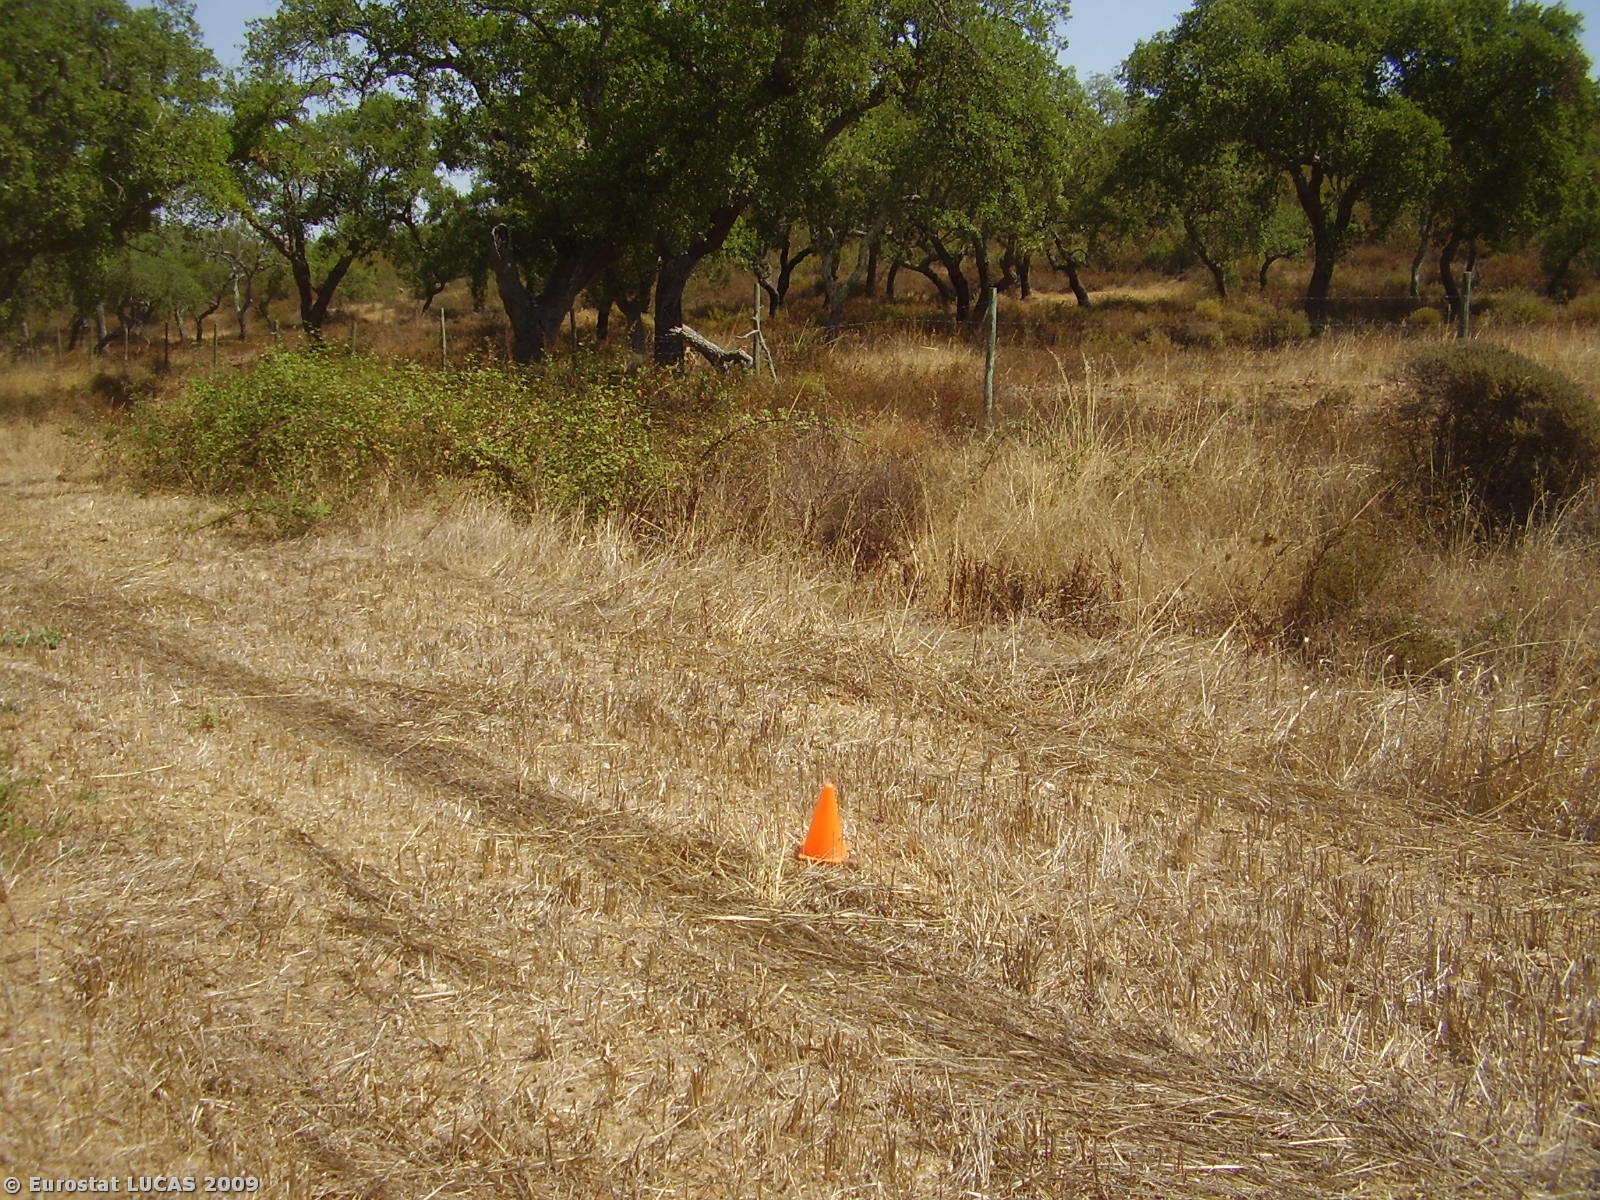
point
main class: Cropland
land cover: Oats
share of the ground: > 75 %
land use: Agriculture (excluding fallow land and kitchen gardens)
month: August
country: PT
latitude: 38.2465
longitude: -7.8455
